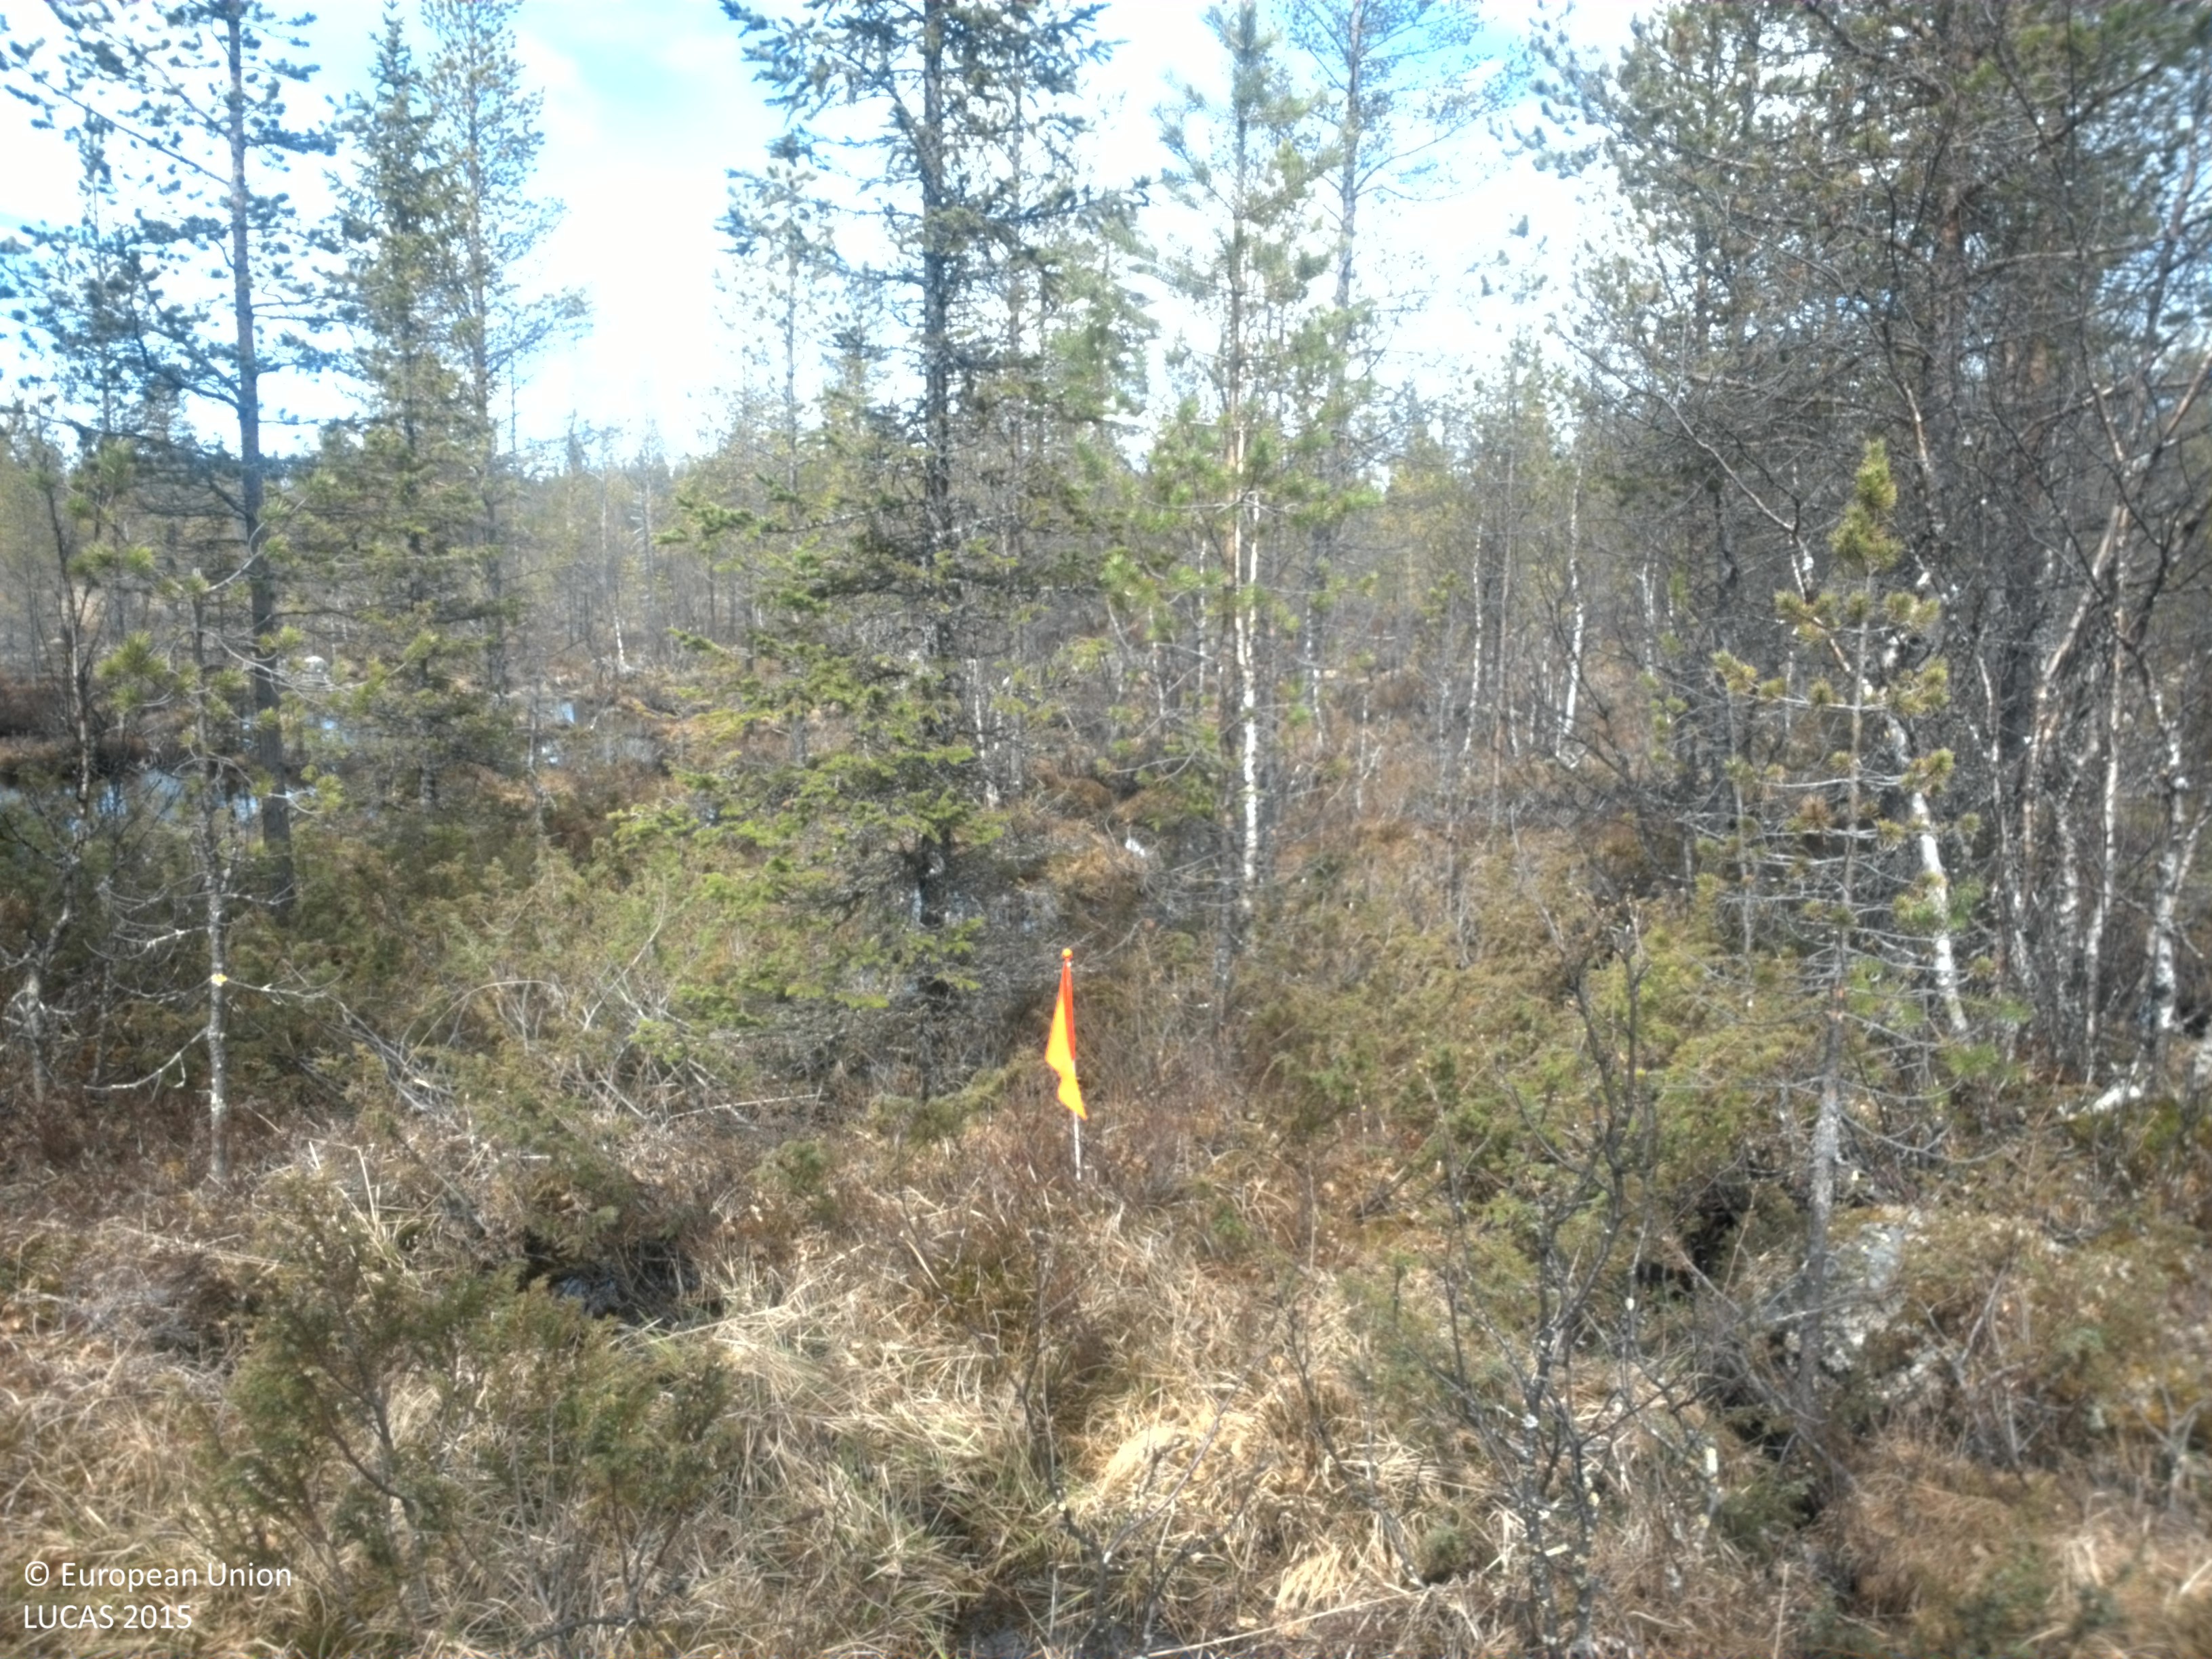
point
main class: Woodland
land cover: Pine dominated mixed woodland
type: boreal forest
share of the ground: 50 - 75 %
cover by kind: coniferous forest trees 50 %, shrubs 30 %, broadleaved forest trees 20 %
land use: Forestry
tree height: > 5 m
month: May
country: SE
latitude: 62.6909
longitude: 13.7928
